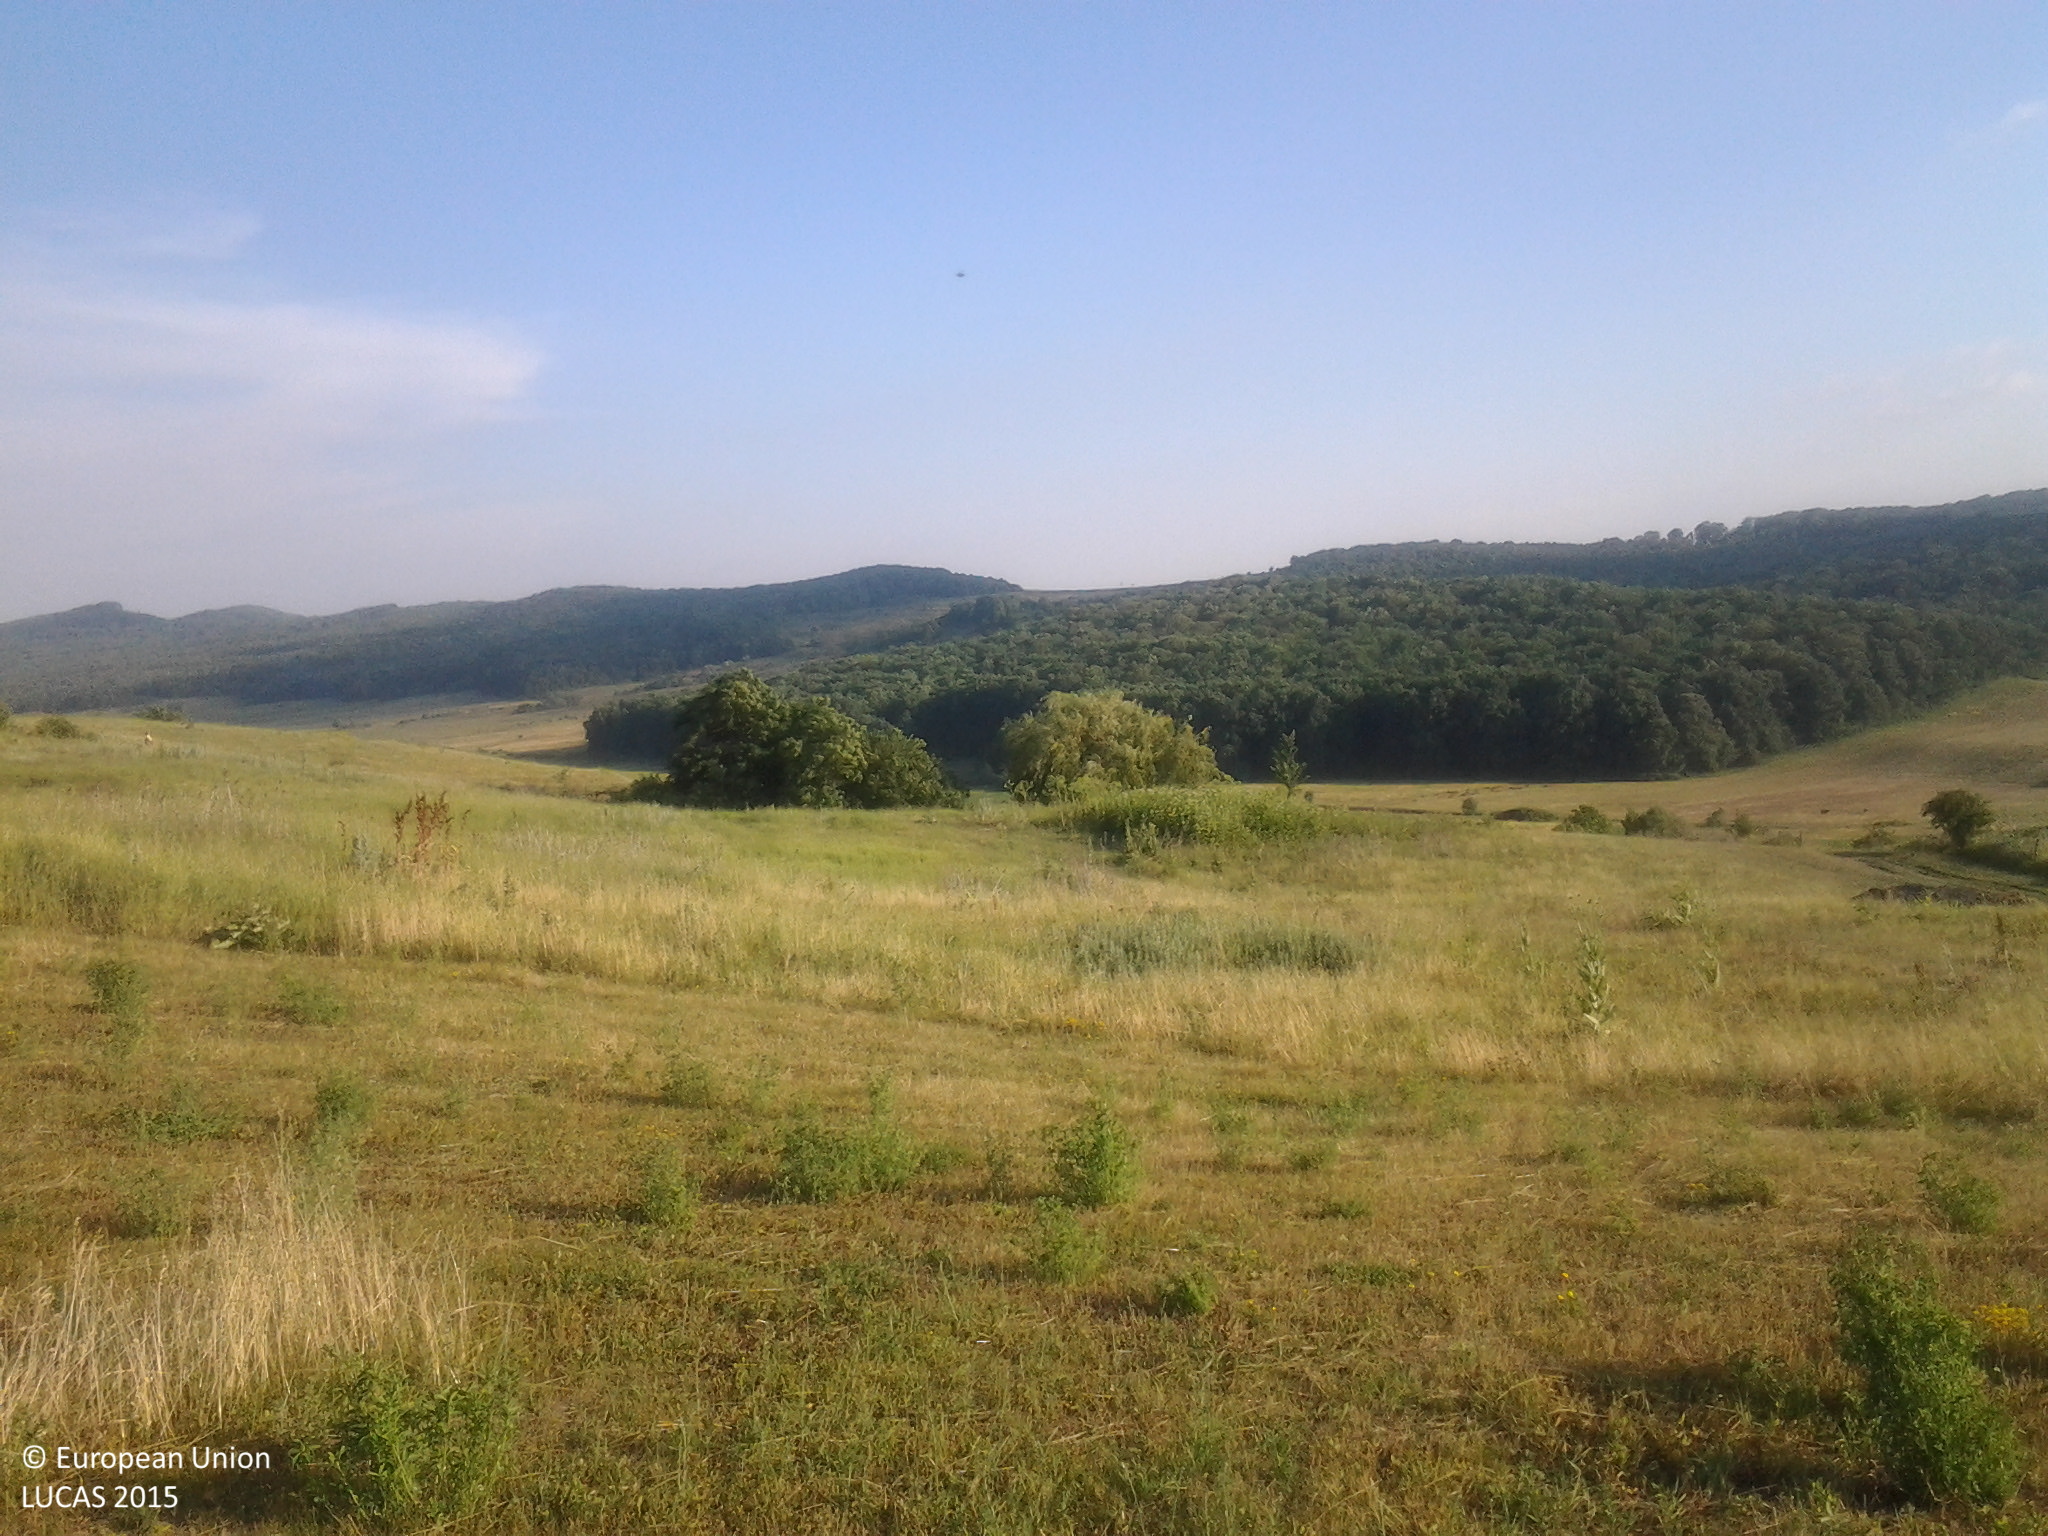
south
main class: Cropland
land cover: Other leguminous and mixtures for fodder
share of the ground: > 75 %
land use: Agriculture (excluding fallow land and kitchen gardens)
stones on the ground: < 10 %
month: June
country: RO
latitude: 46.6317
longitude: 27.1199
